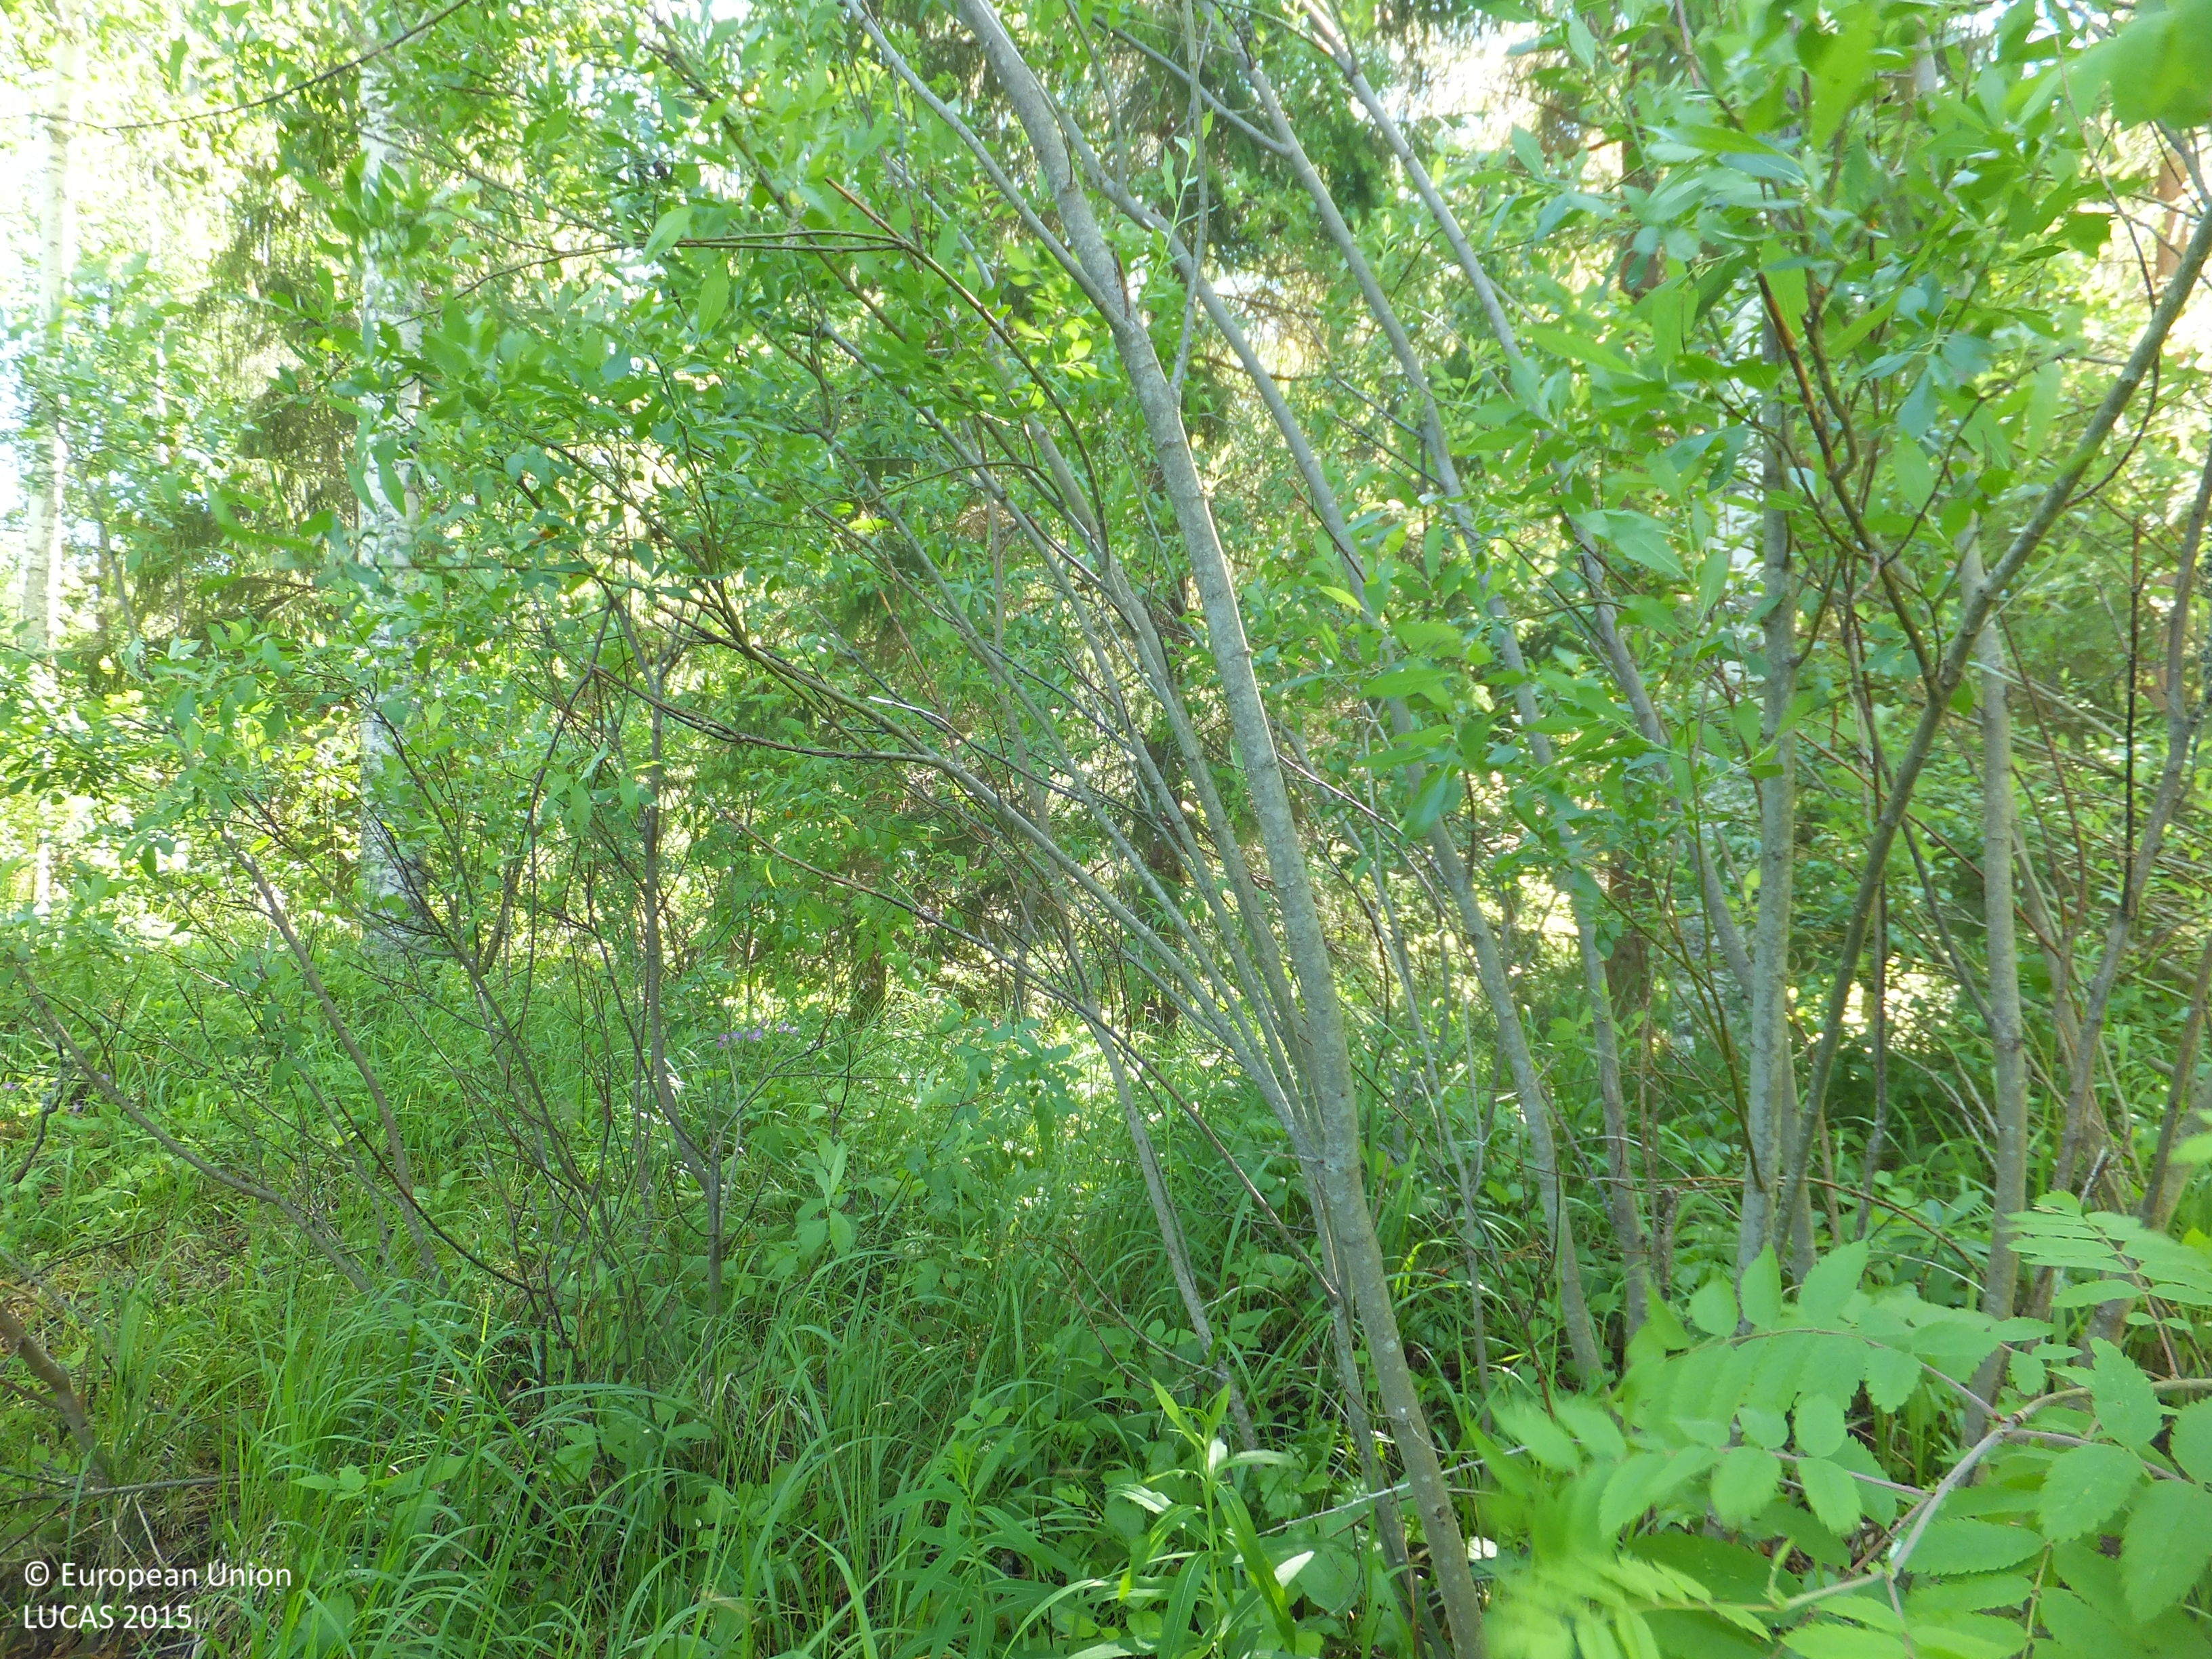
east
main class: Woodland
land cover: Other mixed woodland
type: boreal forest
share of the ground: > 75 %
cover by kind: coniferous forest trees 40 %, broadleaved forest trees 35 %, herbaceous plants 20 %, shrubs 5 %
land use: Forestry
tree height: > 5 m
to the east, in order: Other mixed woodland; Ditches and canals; Spruce dominated mixed woodland; Grassland with sparse tree/shrub cover; Other mixed woodland; Pine dominated mixed woodland; Tracks; Other mixed woodland; Tracks; Spruce dominated mixed woodland
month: July
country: FI
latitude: 63.1320
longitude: 23.9768
